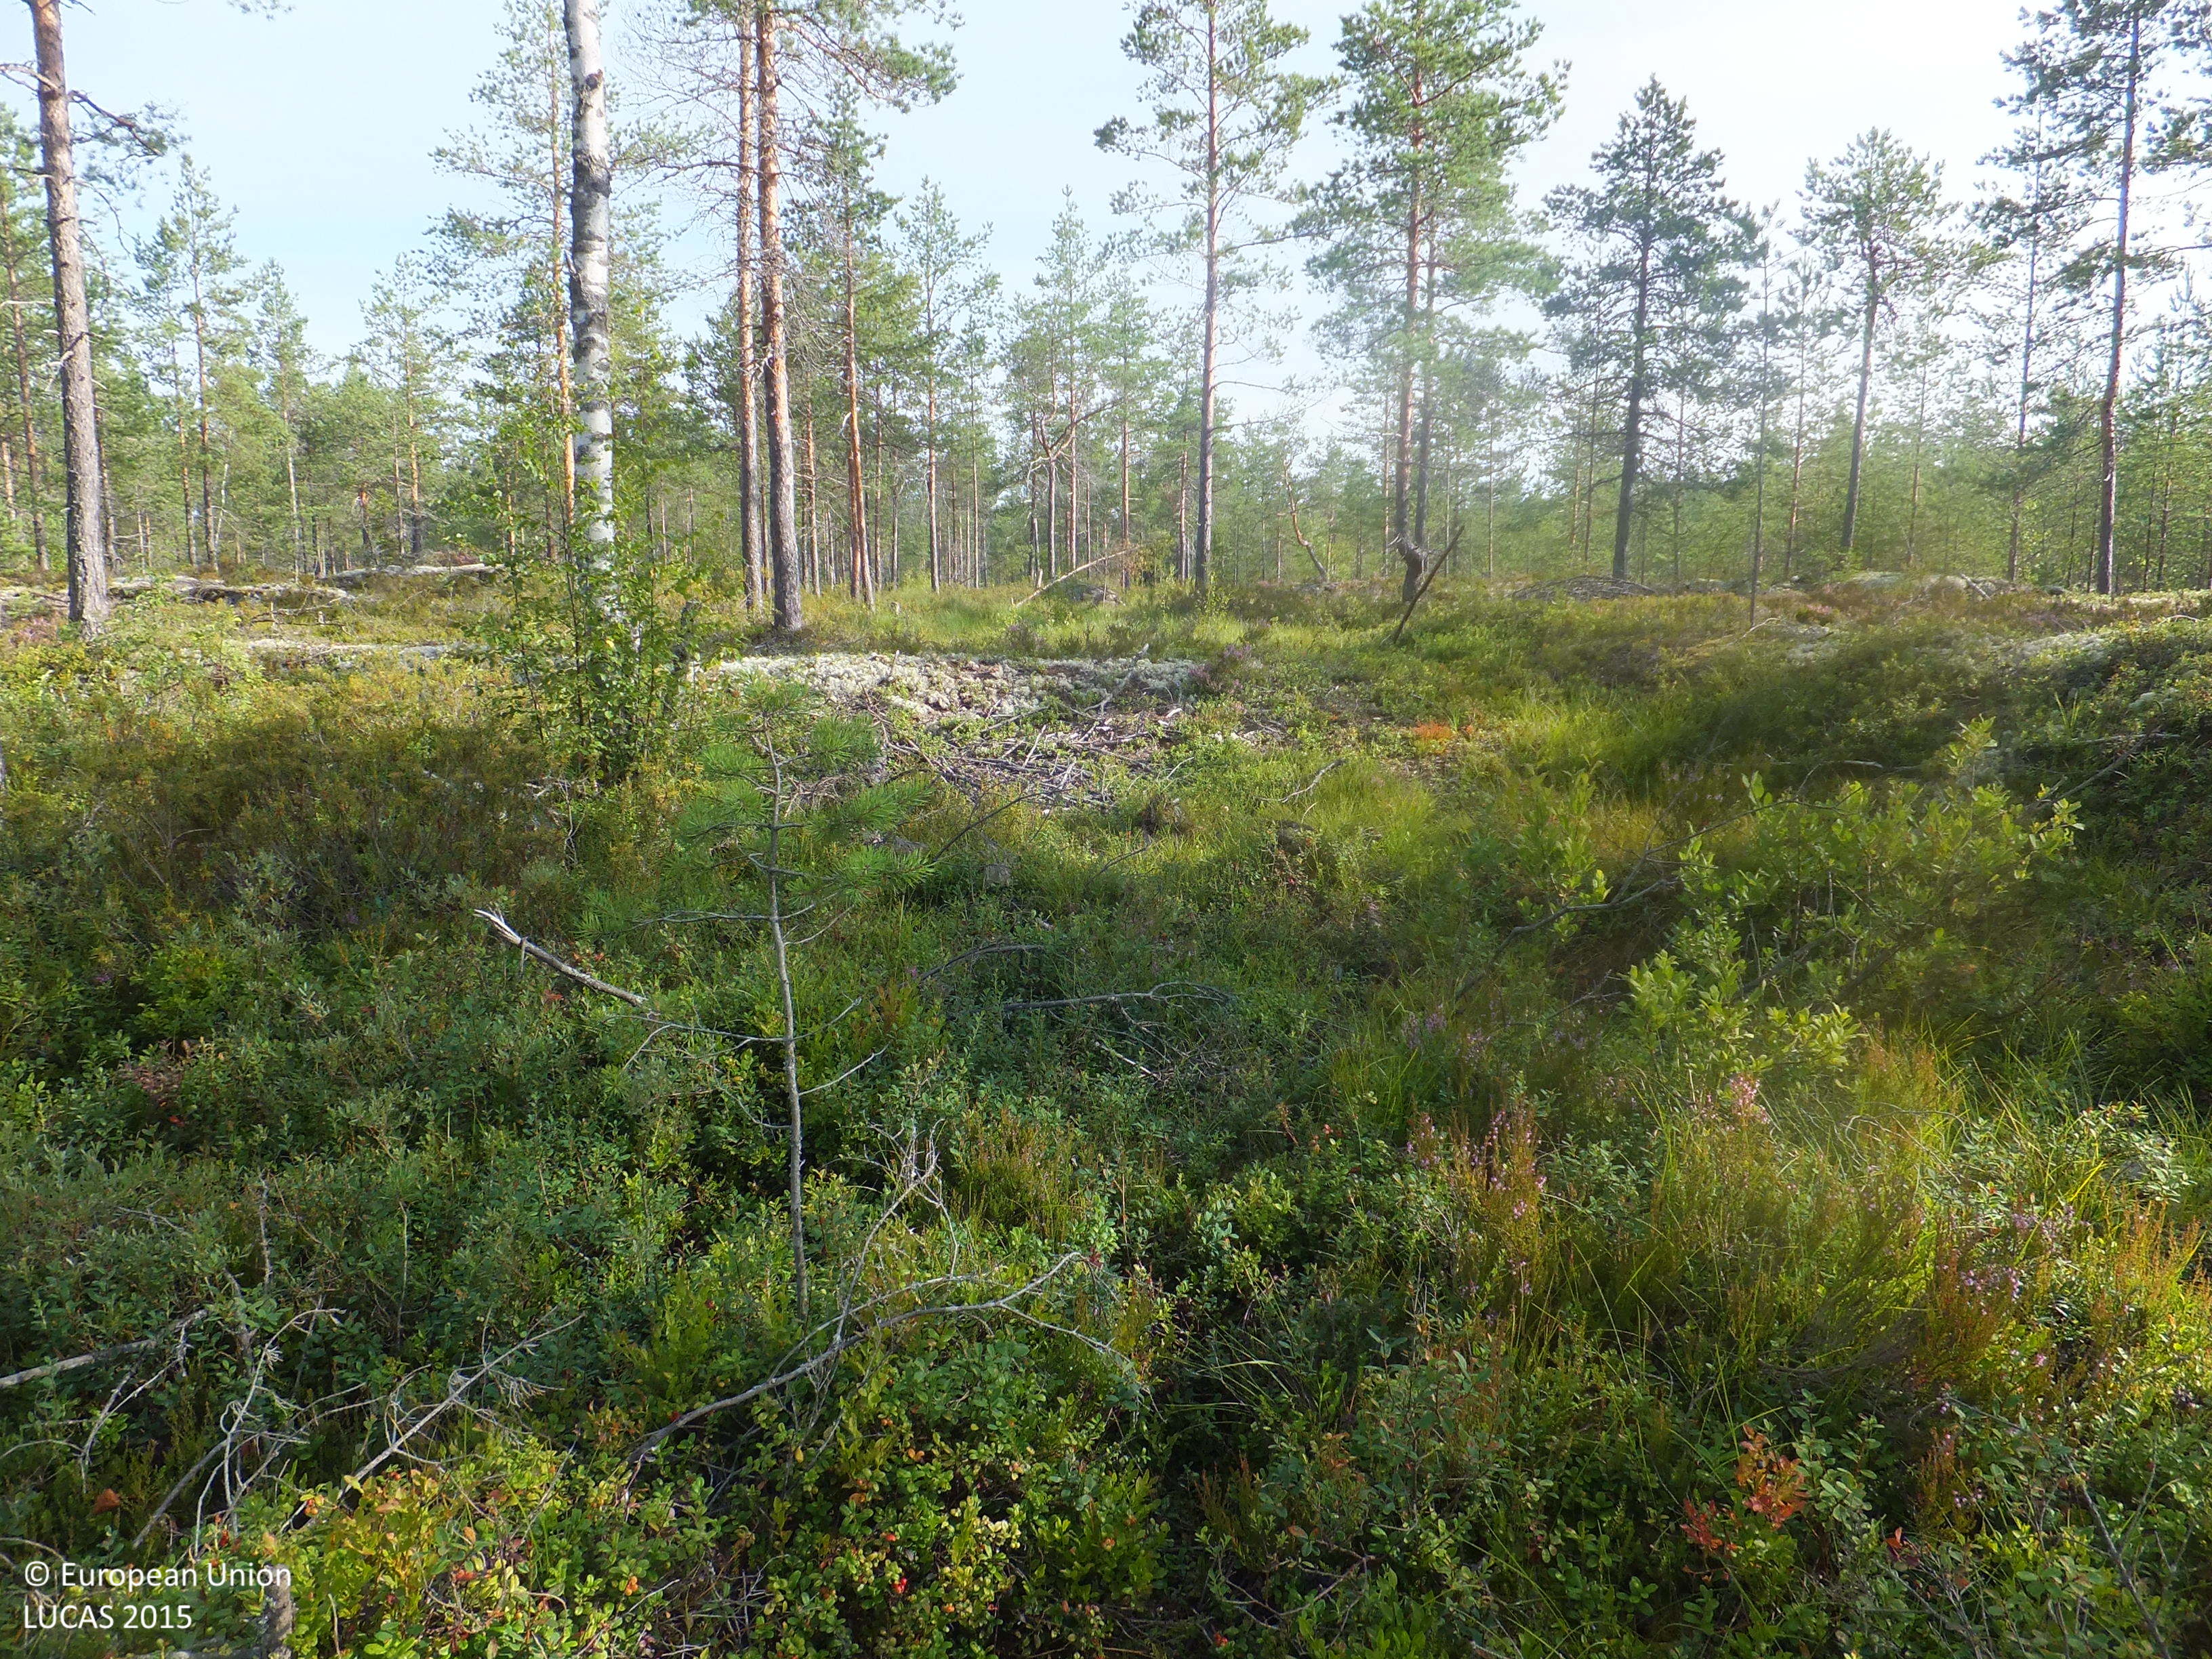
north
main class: Woodland
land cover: Pine dominated coniferous woodland
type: boreal forest
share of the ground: 25 - 50 %
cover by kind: coniferous forest trees 35 %, shrubs 30 %, lichens and mosses 15 %, herbaceous plants 10 %, broadleaved forest trees 5 %, consolidated bare surface 5 %
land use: Forestry
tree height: > 5 m
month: August
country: FI
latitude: 63.1442
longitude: 23.0142
